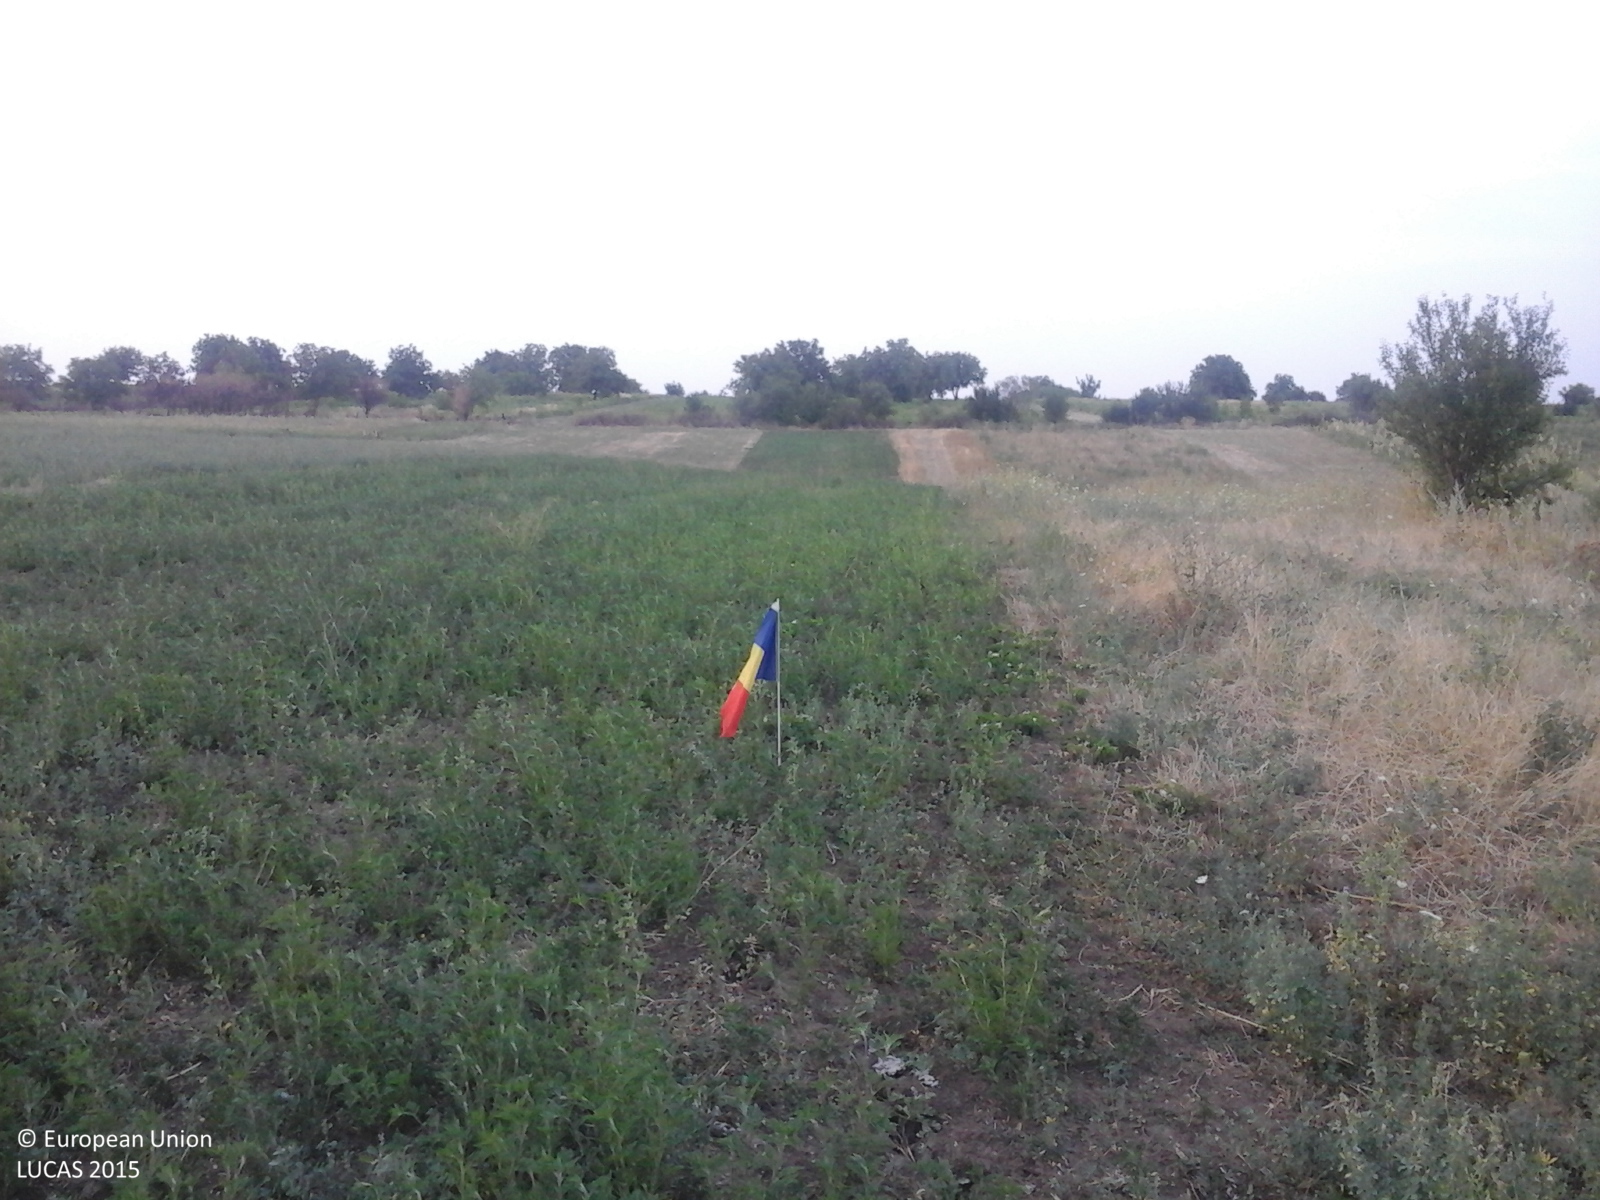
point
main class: Cropland
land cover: Lucerne
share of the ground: > 75 %
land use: Agriculture (excluding fallow land and kitchen gardens)
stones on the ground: < 10 %
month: August
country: RO
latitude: 44.3194
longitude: 23.0979
